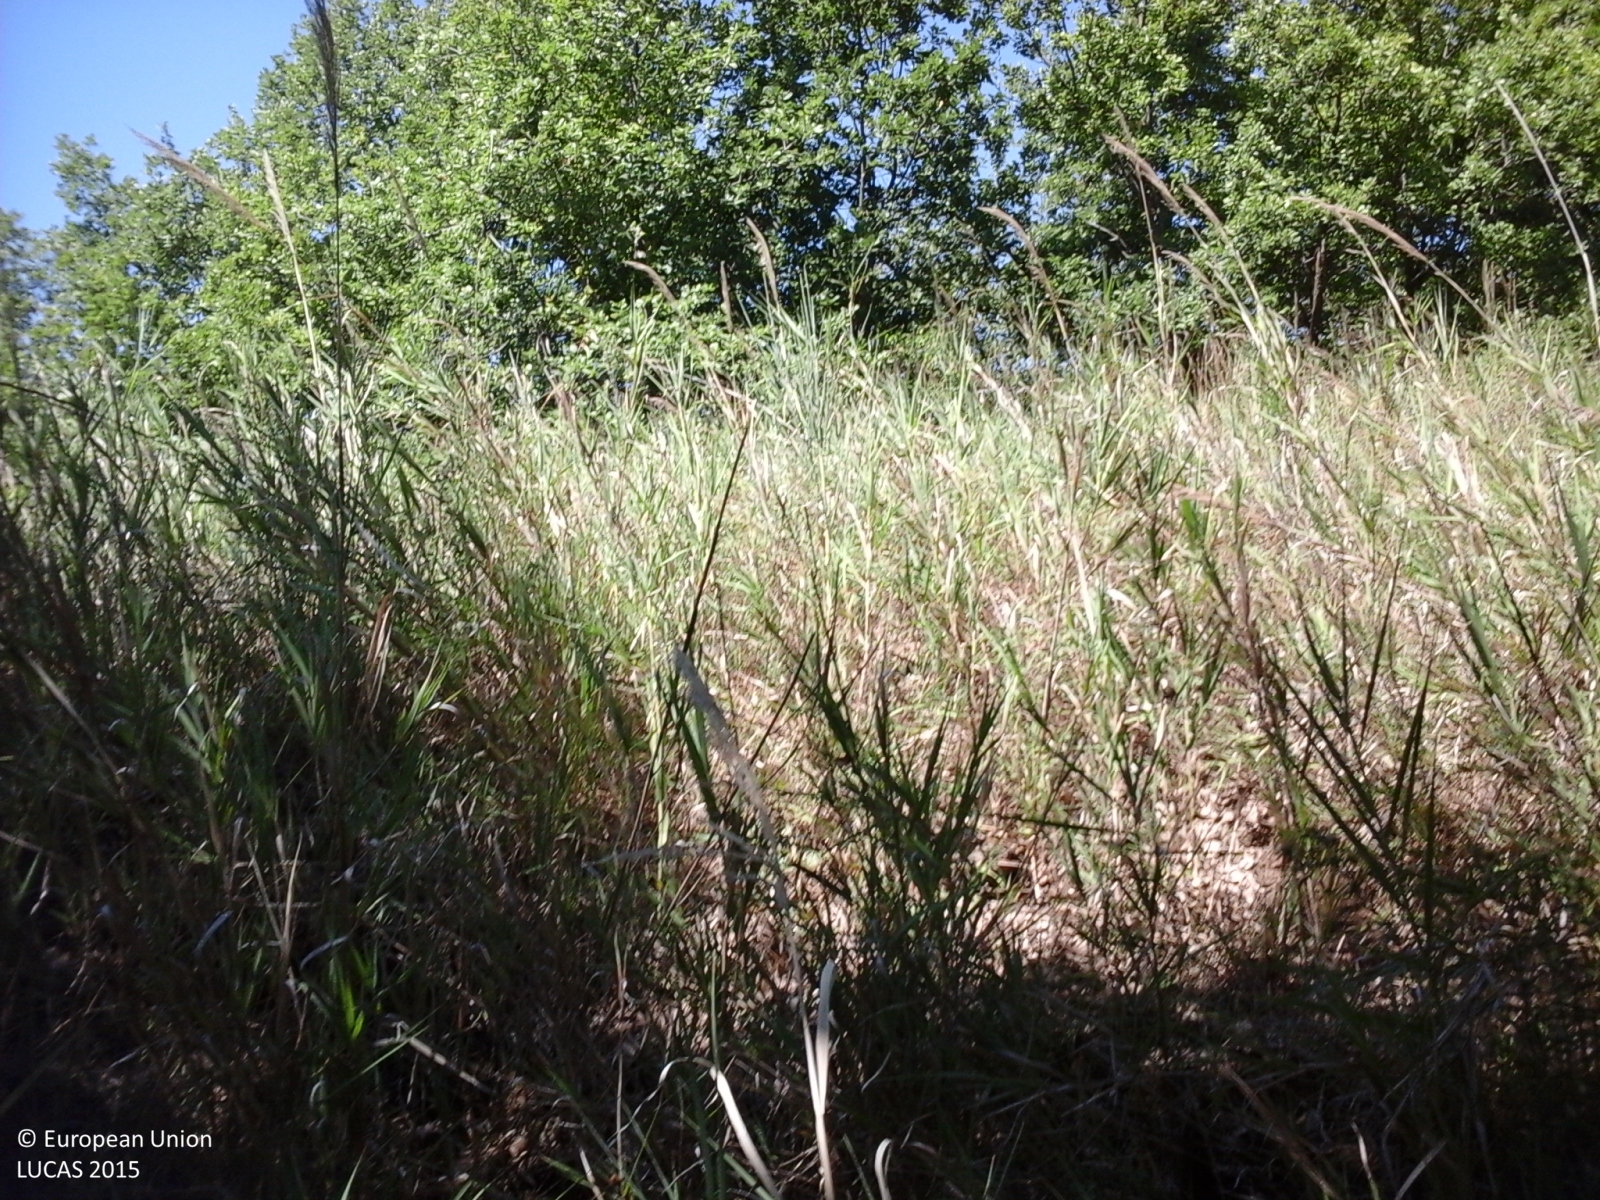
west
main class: Woodland
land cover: Broadleaved woodland
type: thermophilous deciduous forest
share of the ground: > 75 %
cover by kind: broadleaved forest trees 100 %
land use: Forestry
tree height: > 5 m
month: August
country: IT
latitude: 43.0499
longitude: 13.3668
